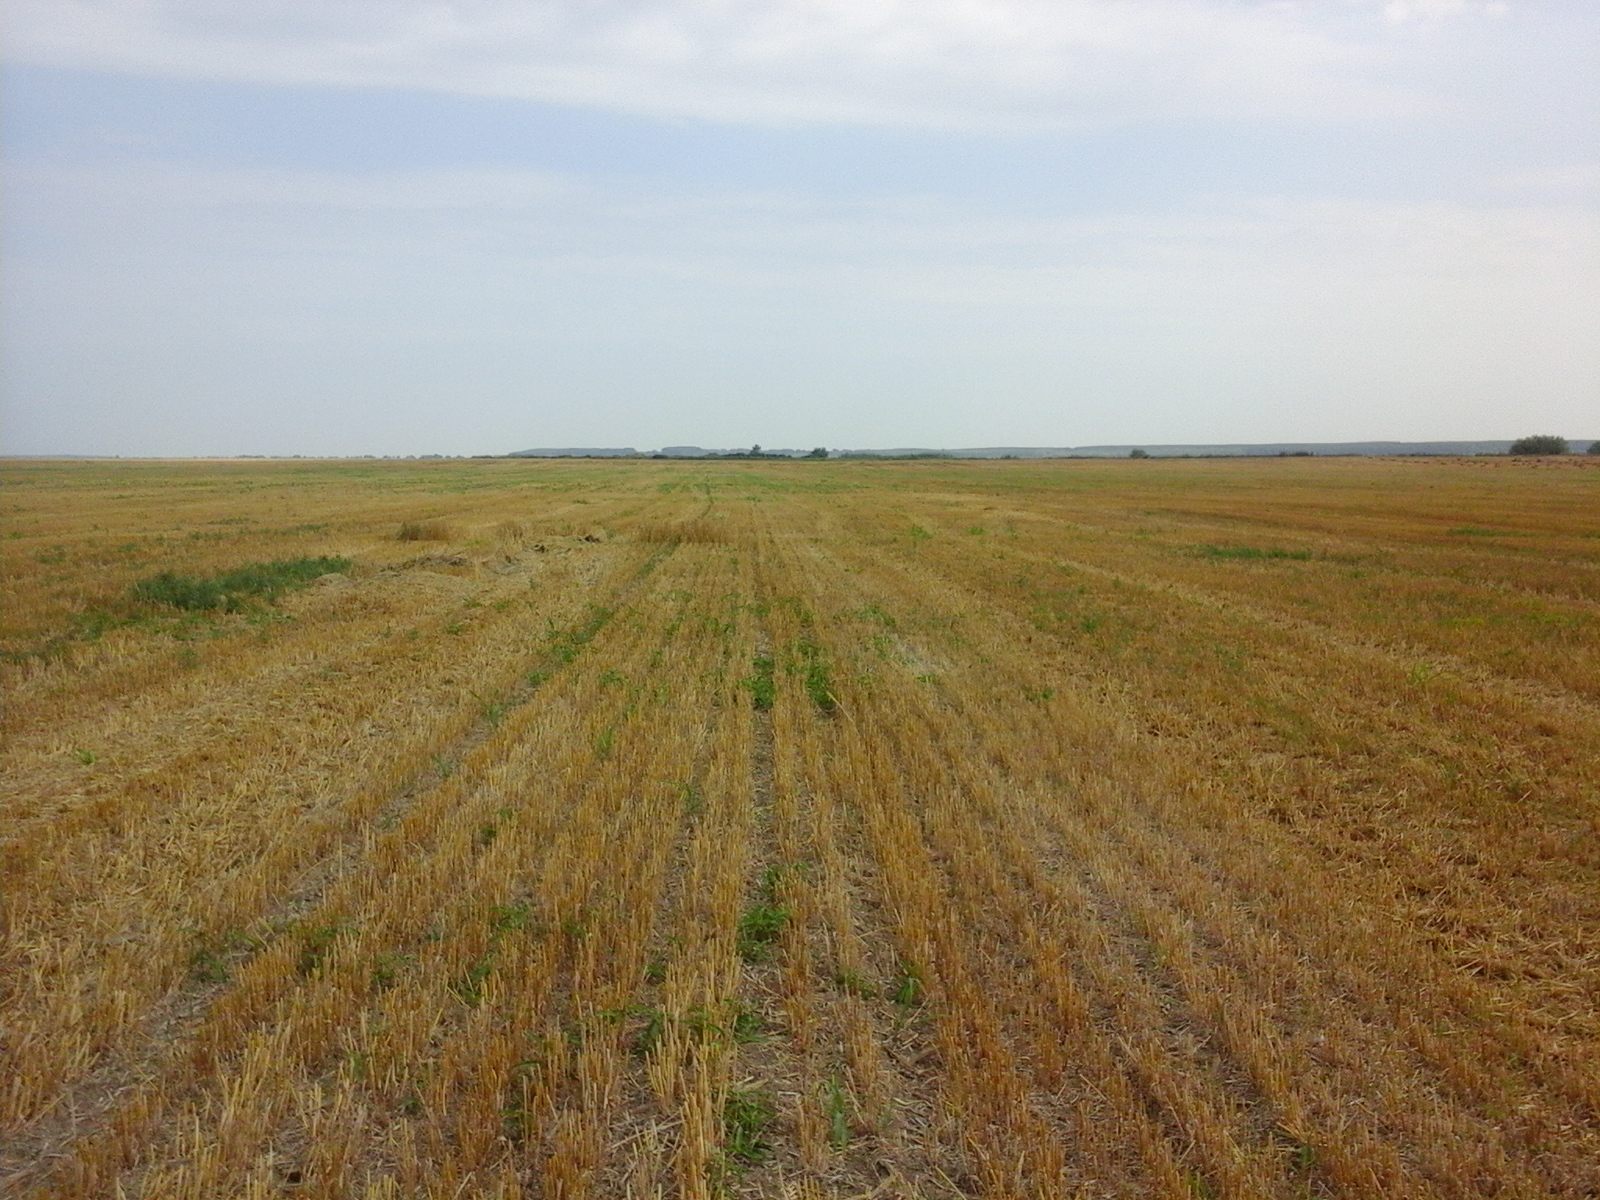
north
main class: Cropland
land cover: Common wheat
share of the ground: > 75 %
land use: Agriculture (excluding fallow land and kitchen gardens)
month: July
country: RO
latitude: 44.4763
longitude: 27.9970
